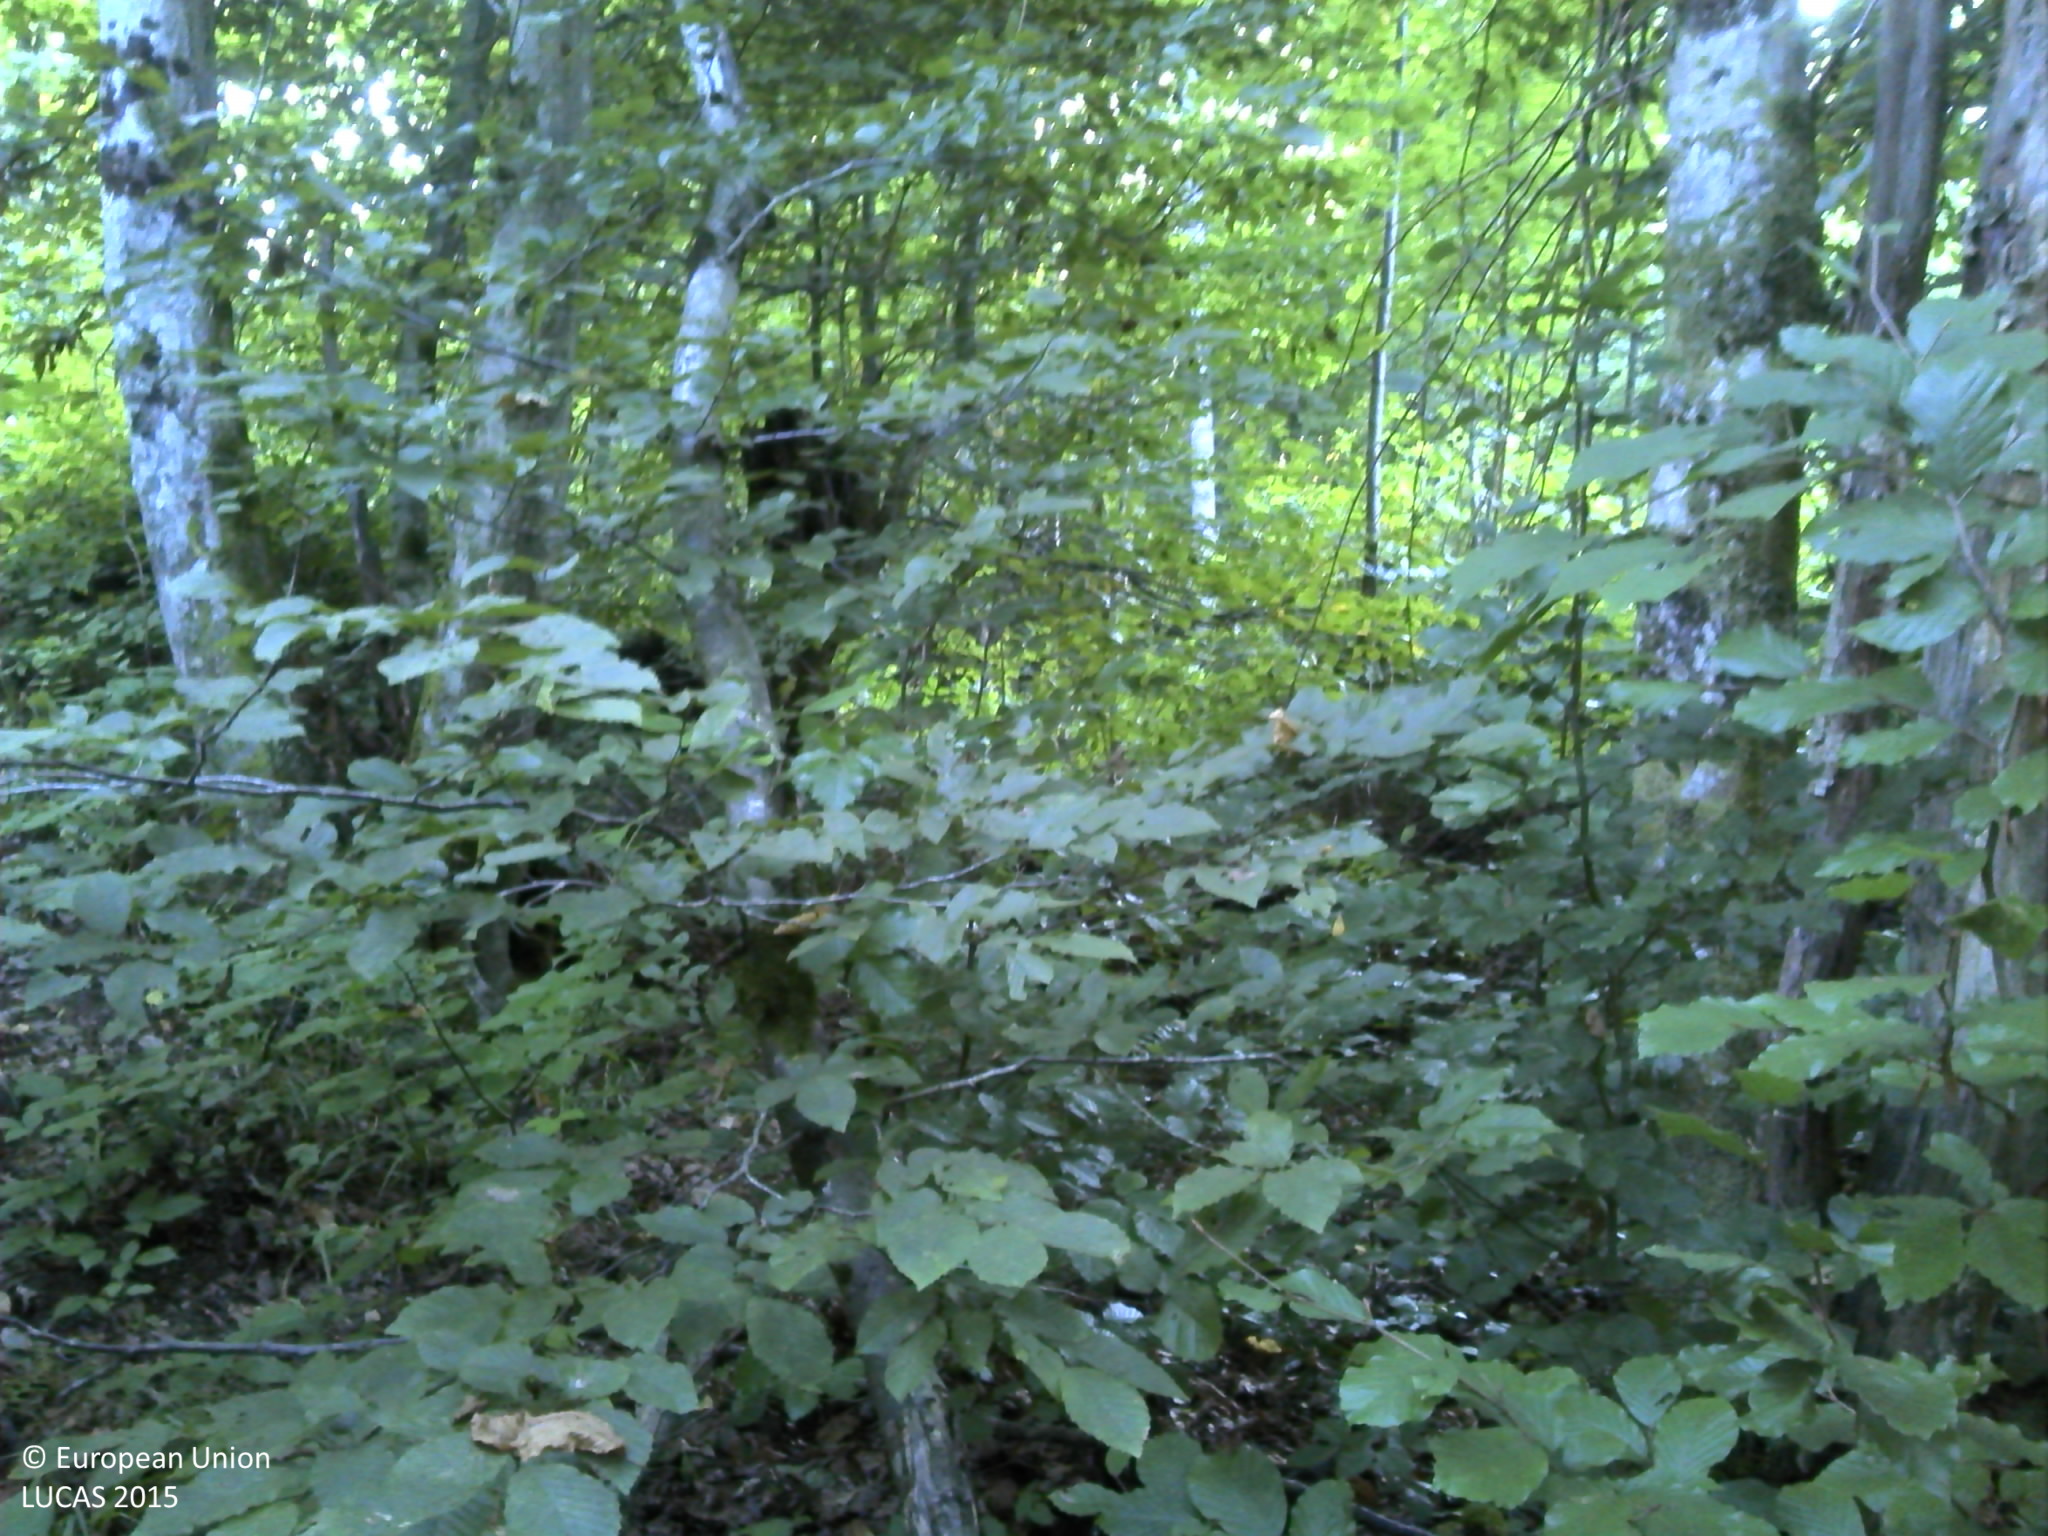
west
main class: Woodland
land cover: Broadleaved woodland
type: beech forest
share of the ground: > 75 %
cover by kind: broadleaved forest trees 100 %
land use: Forestry
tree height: > 5 m
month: August
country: HR
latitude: 45.3031
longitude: 16.5145
